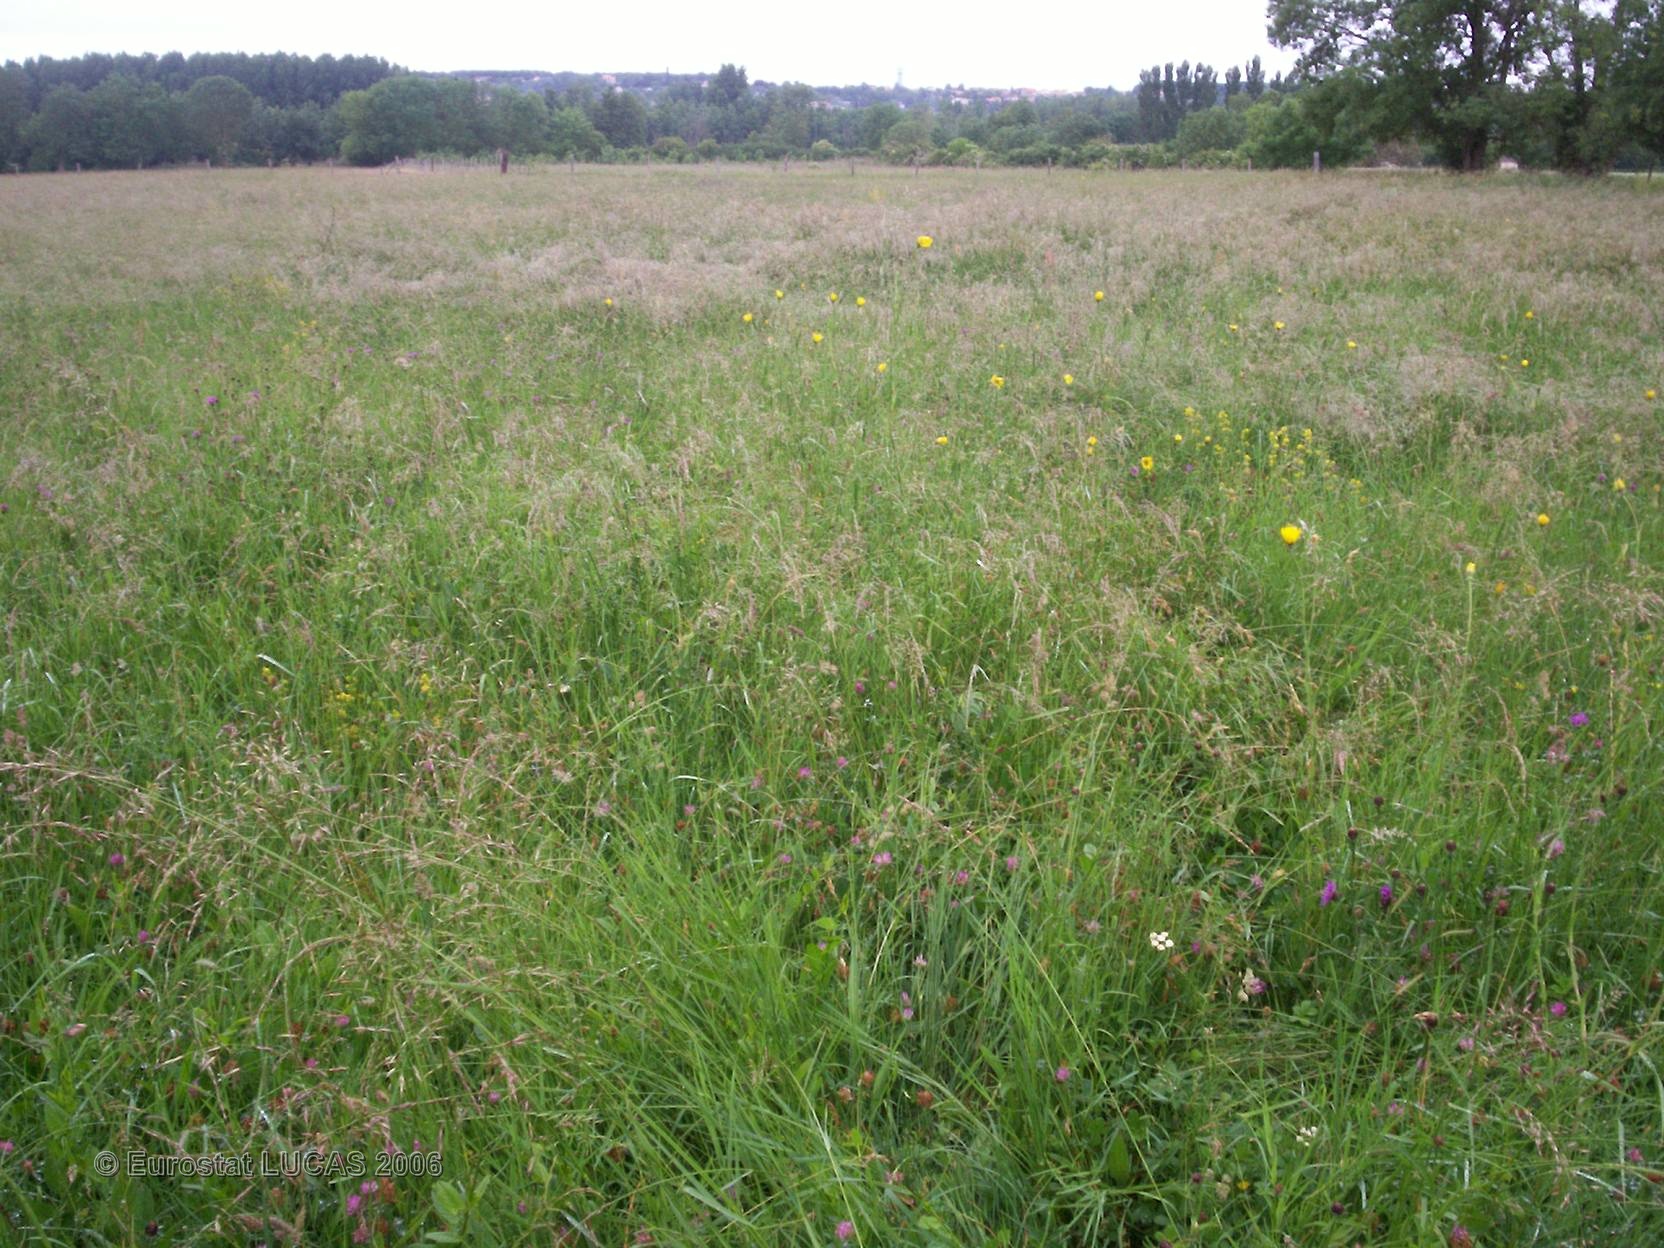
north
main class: Cropland
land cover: Other fresh vegetables
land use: Kitchen garden
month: May
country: FR
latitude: 46.7202
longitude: 0.4436
